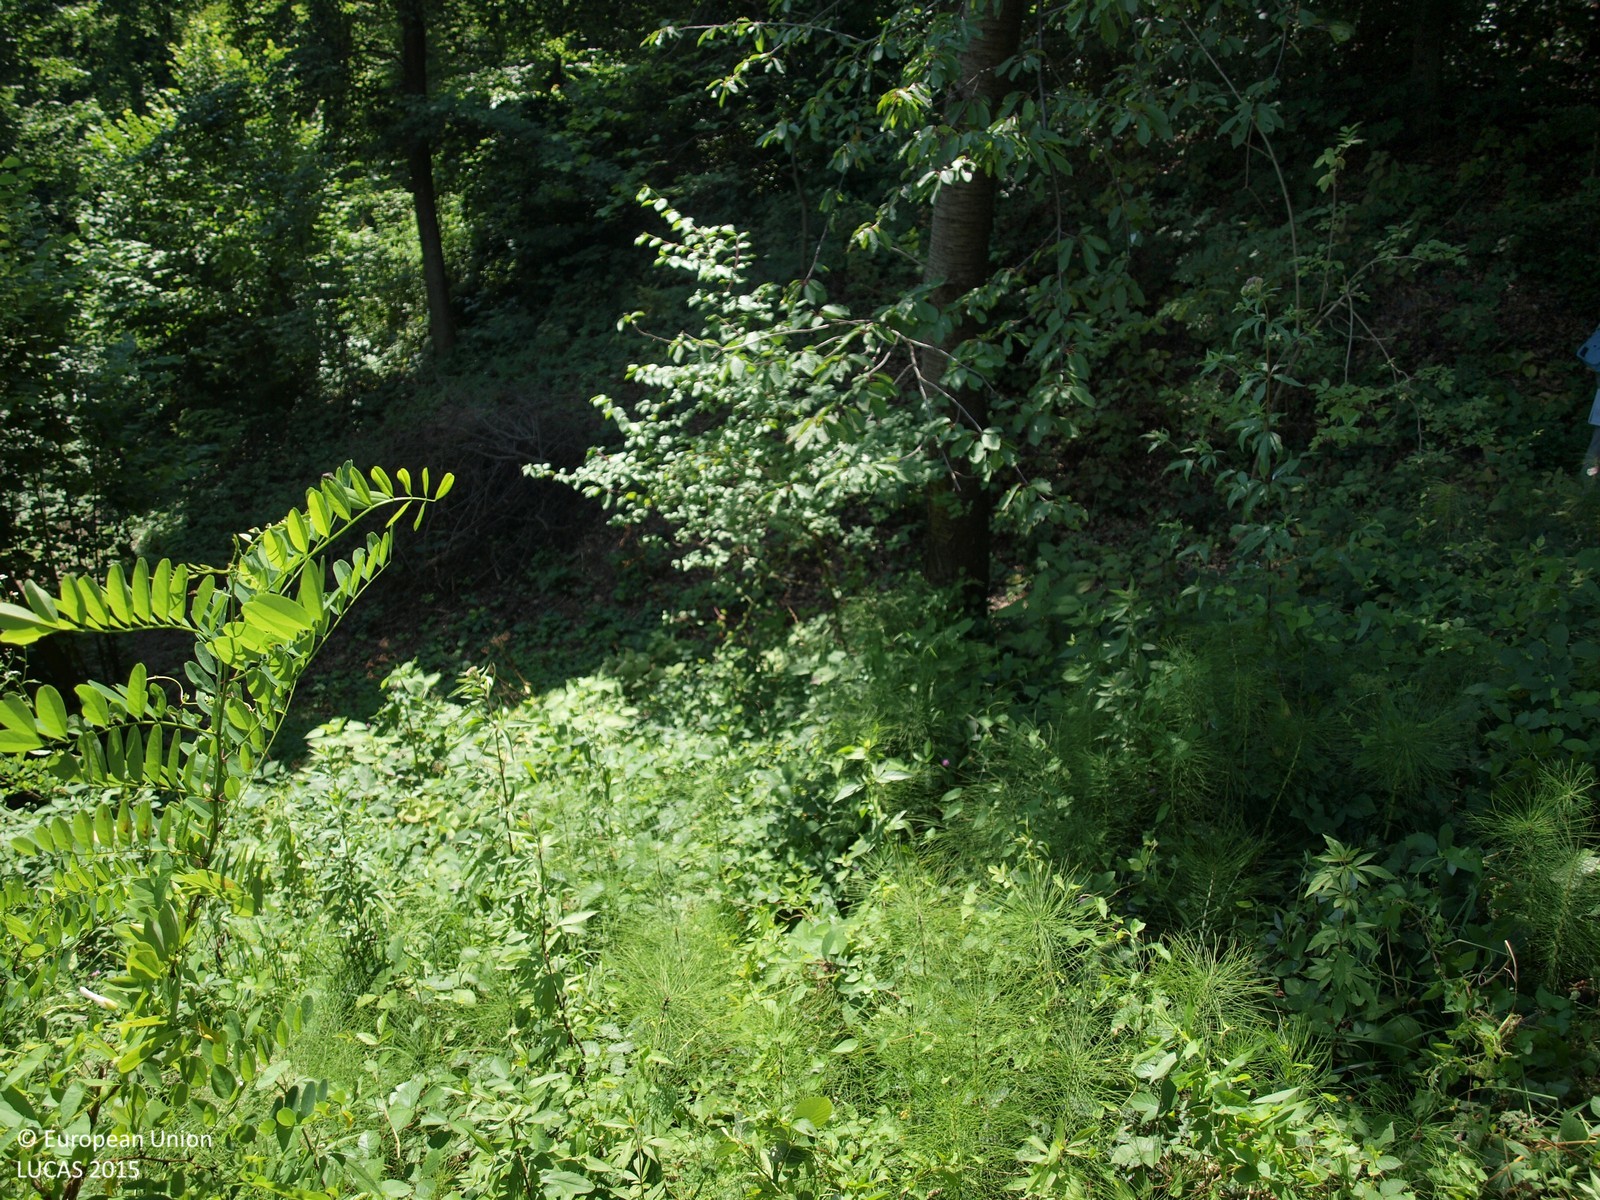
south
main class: Shrubland
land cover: Shrubland with sparse tree cover
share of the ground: > 75 %
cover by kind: shrubs 85 %, herbaceous plants 10 %, broadleaved forest trees 5 %
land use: Semi-natural and natural areas not in use
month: July
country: HR
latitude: 46.0781
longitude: 15.9337
